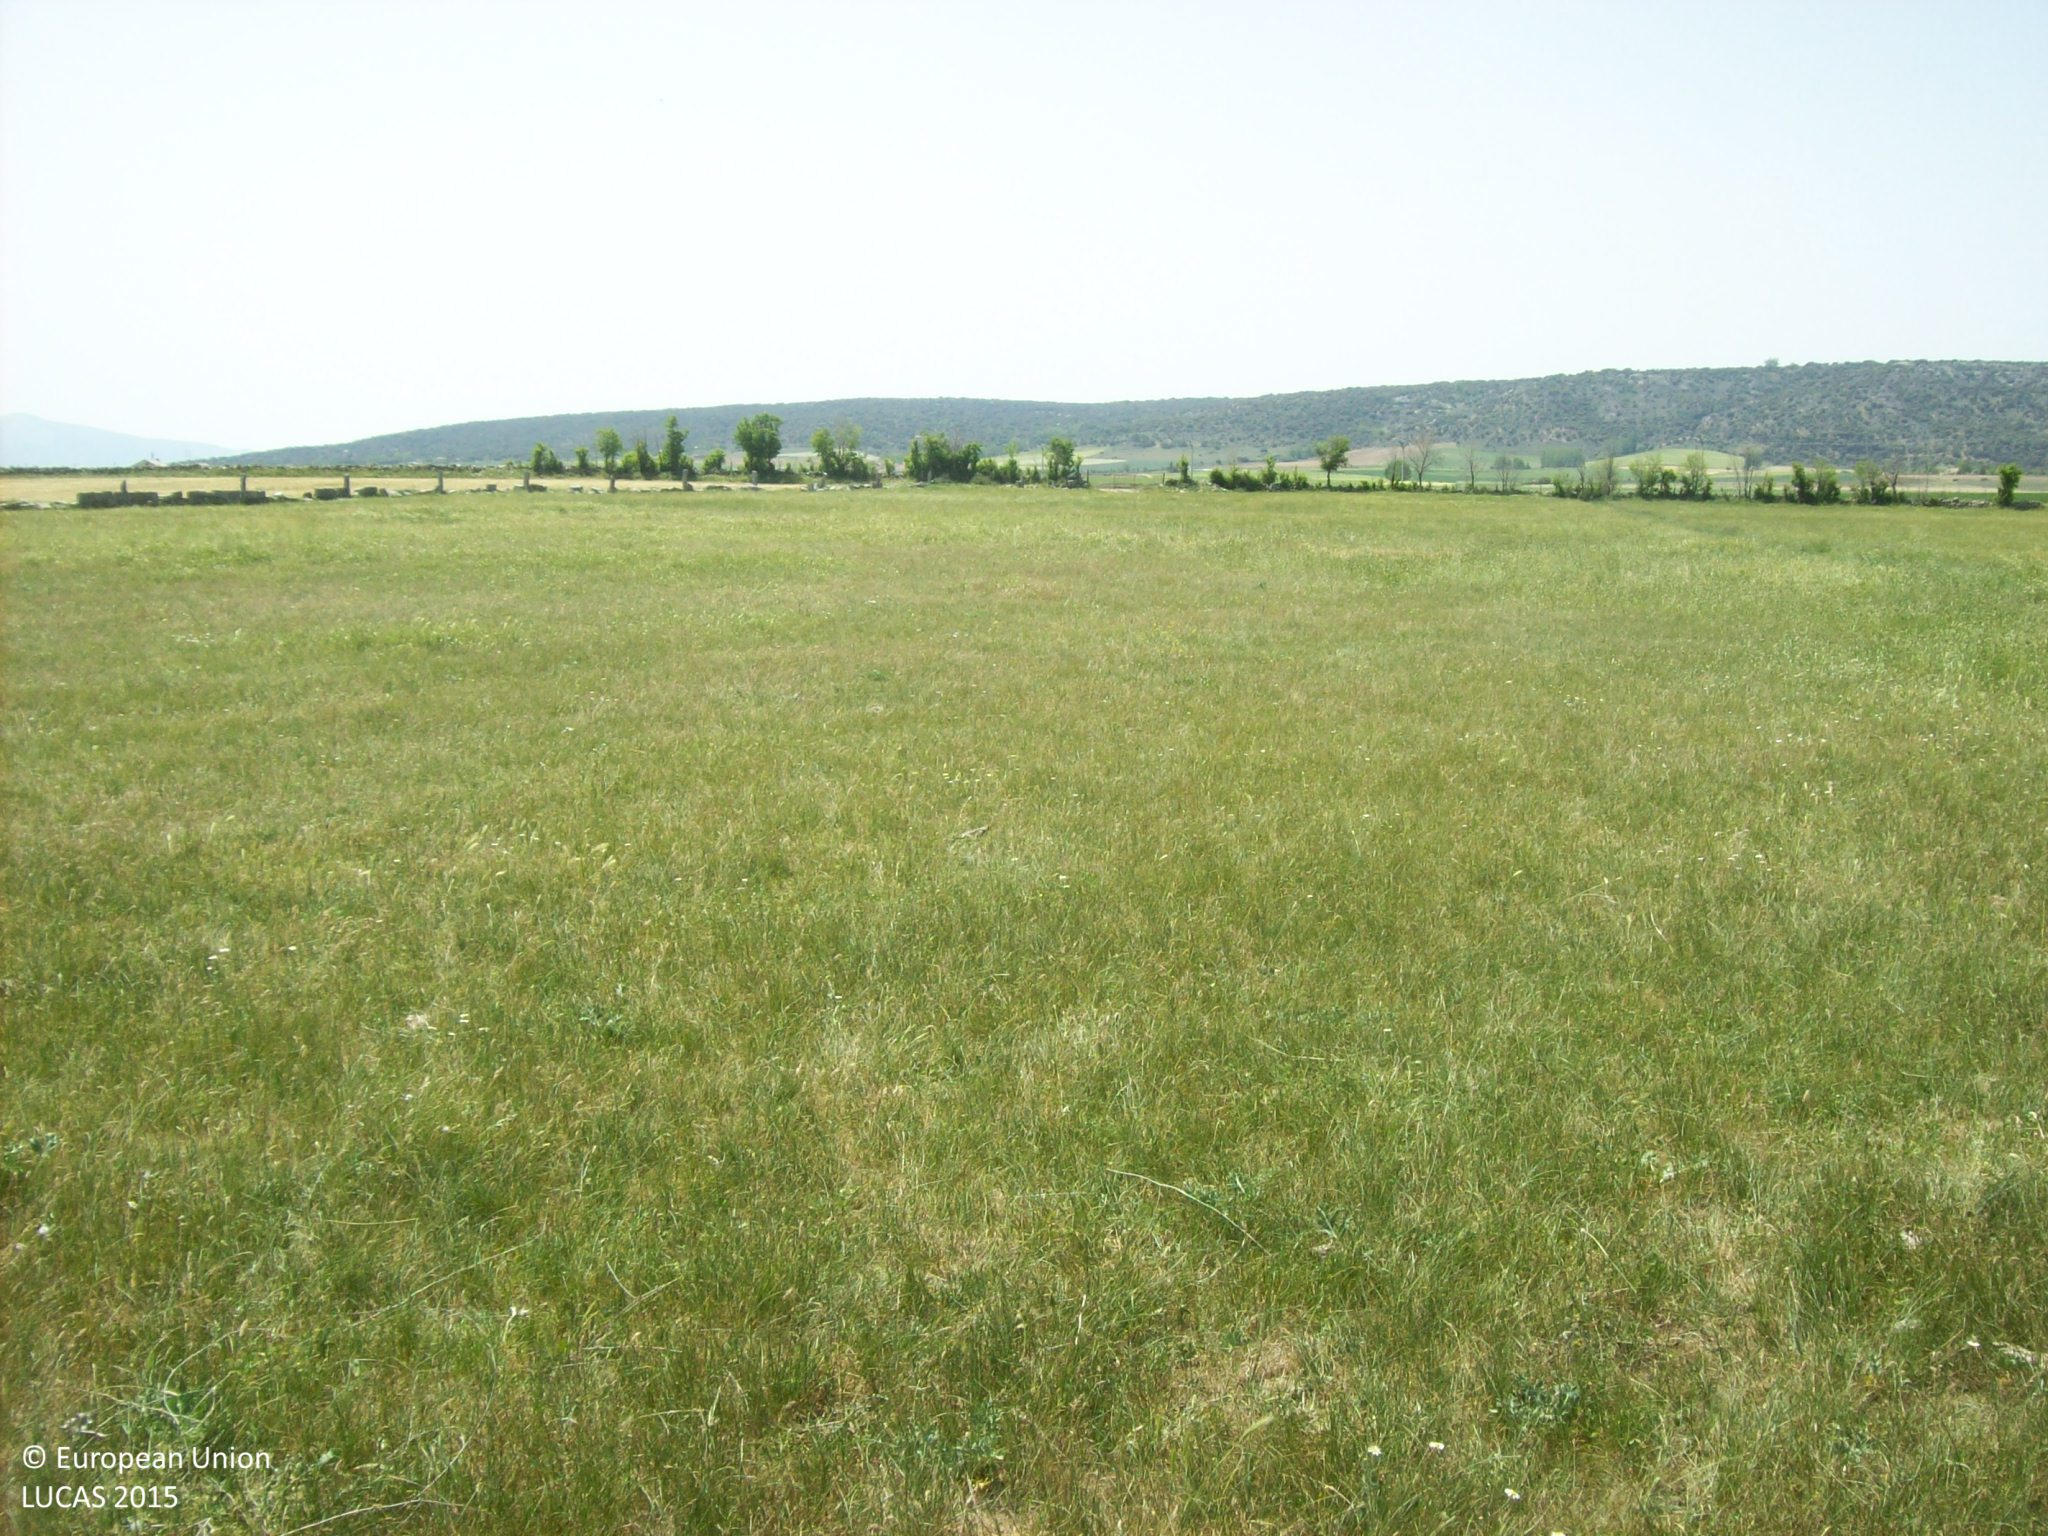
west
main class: Grassland
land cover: Grassland without tree/shrub cover
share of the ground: > 75 %
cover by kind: herbaceous plants 100 %
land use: Agriculture (excluding fallow land and kitchen gardens)
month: May
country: ES
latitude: 40.6178
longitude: -4.8448
